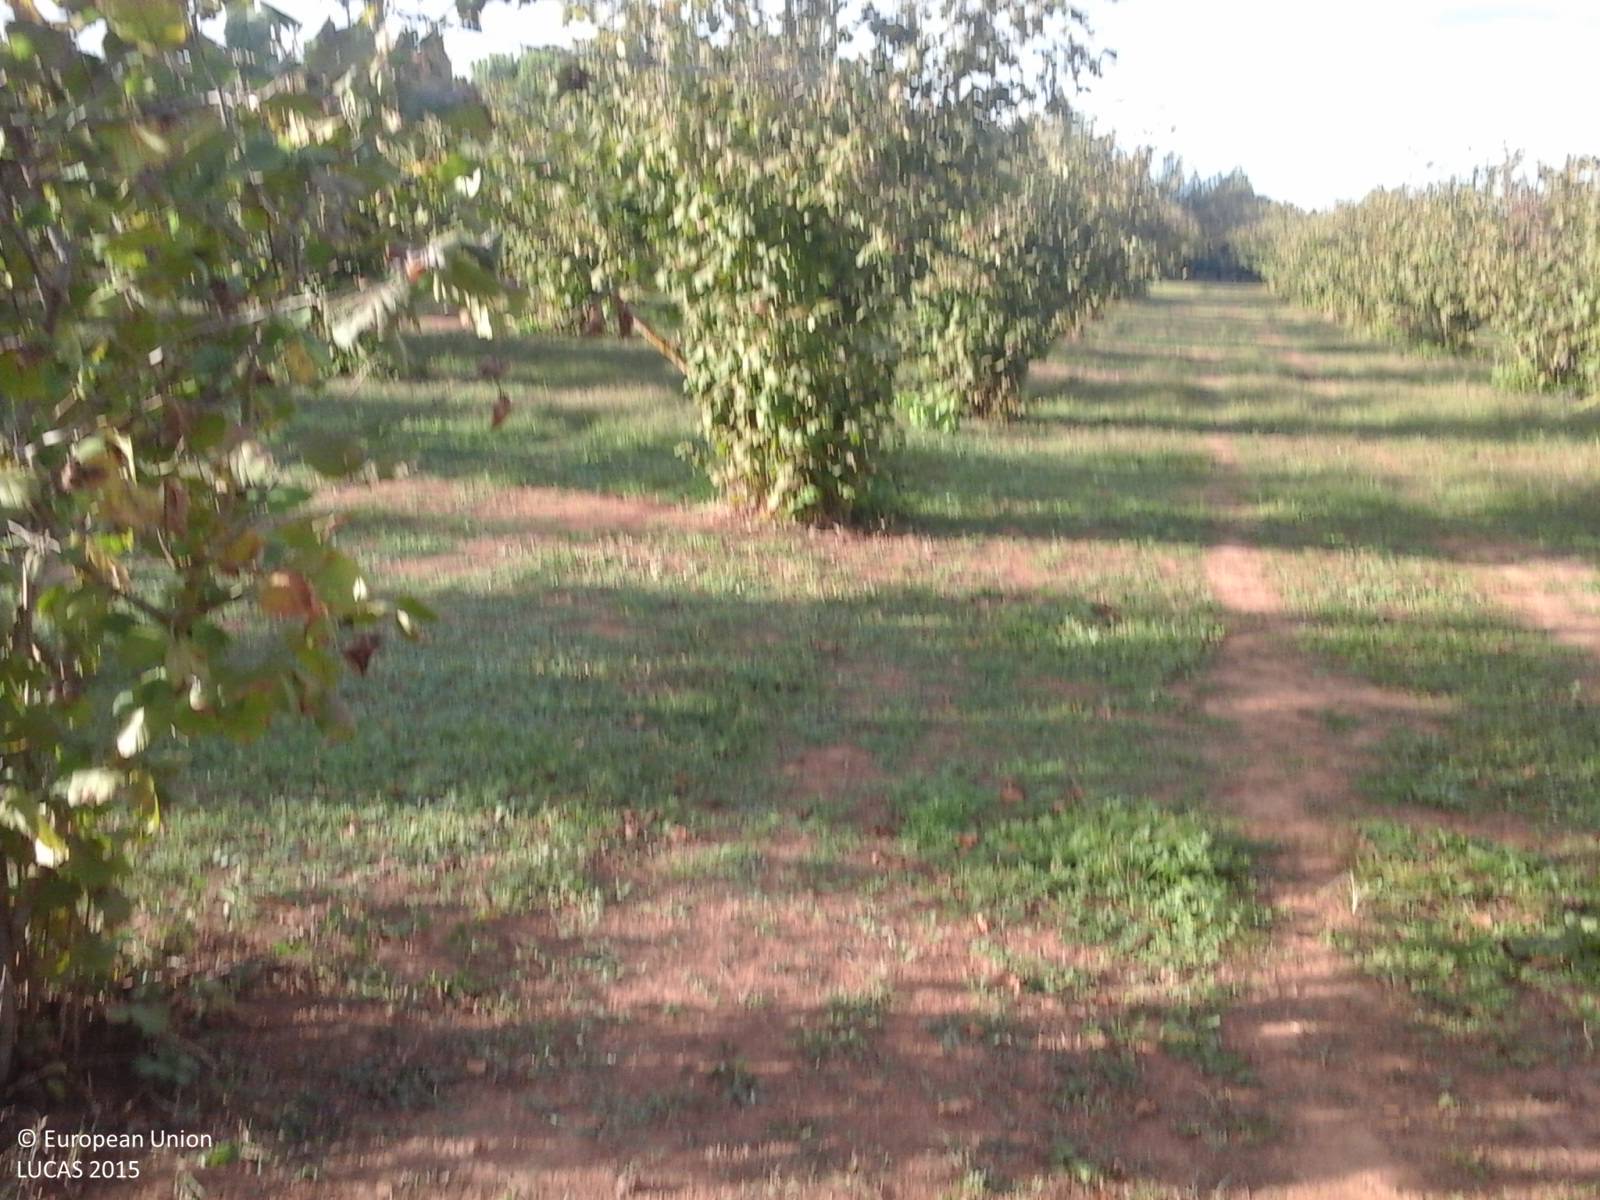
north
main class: Cropland
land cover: Nuts trees
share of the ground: > 75 %
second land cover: Spontaneously vegetated surfaces
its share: > 75 %
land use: Agriculture (excluding fallow land and kitchen gardens)
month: September
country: IT
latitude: 42.4102
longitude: 12.3373
